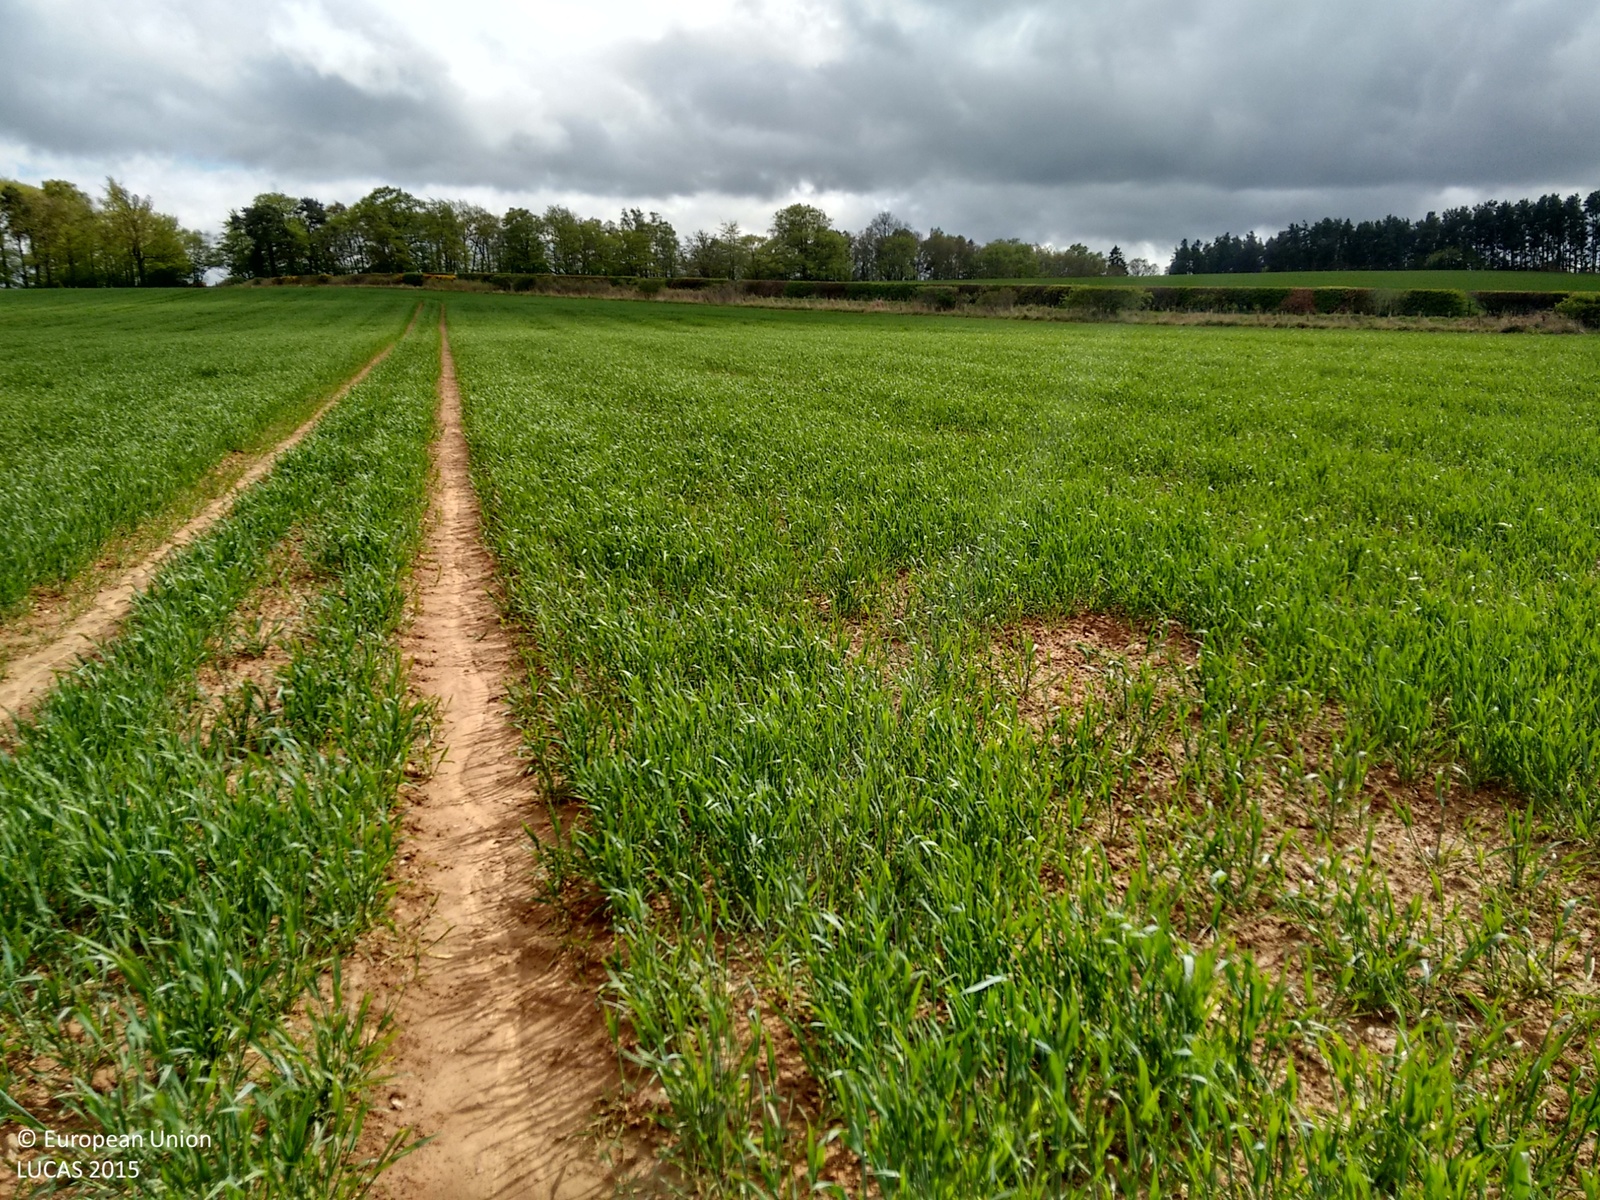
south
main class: Cropland
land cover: Oats
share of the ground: 25 - 50 %
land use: Agriculture (excluding fallow land and kitchen gardens)
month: May
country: GB
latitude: 55.6129
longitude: -2.6530
